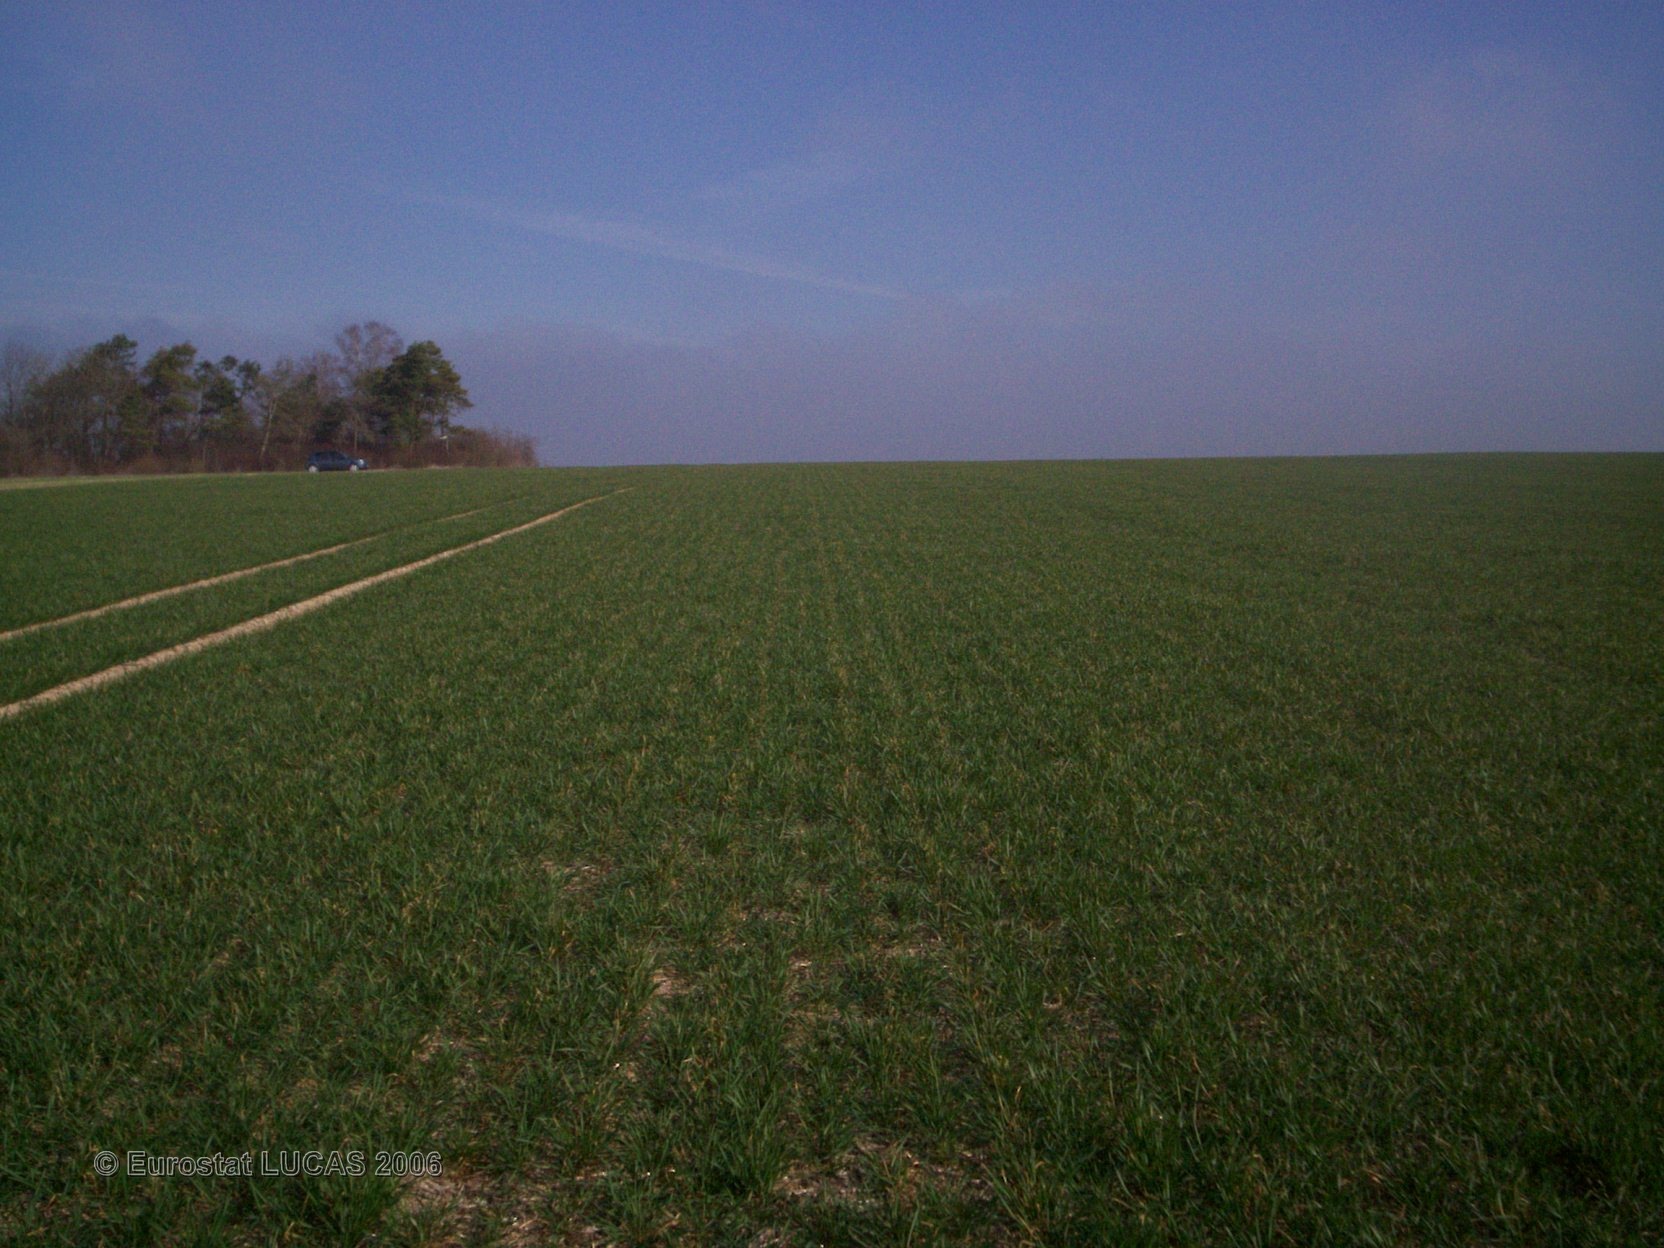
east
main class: Cropland
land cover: Barley
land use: Agriculture (excluding fallow land and kitchen gardens)
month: April
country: FR
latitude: 49.1196
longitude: 4.6121
